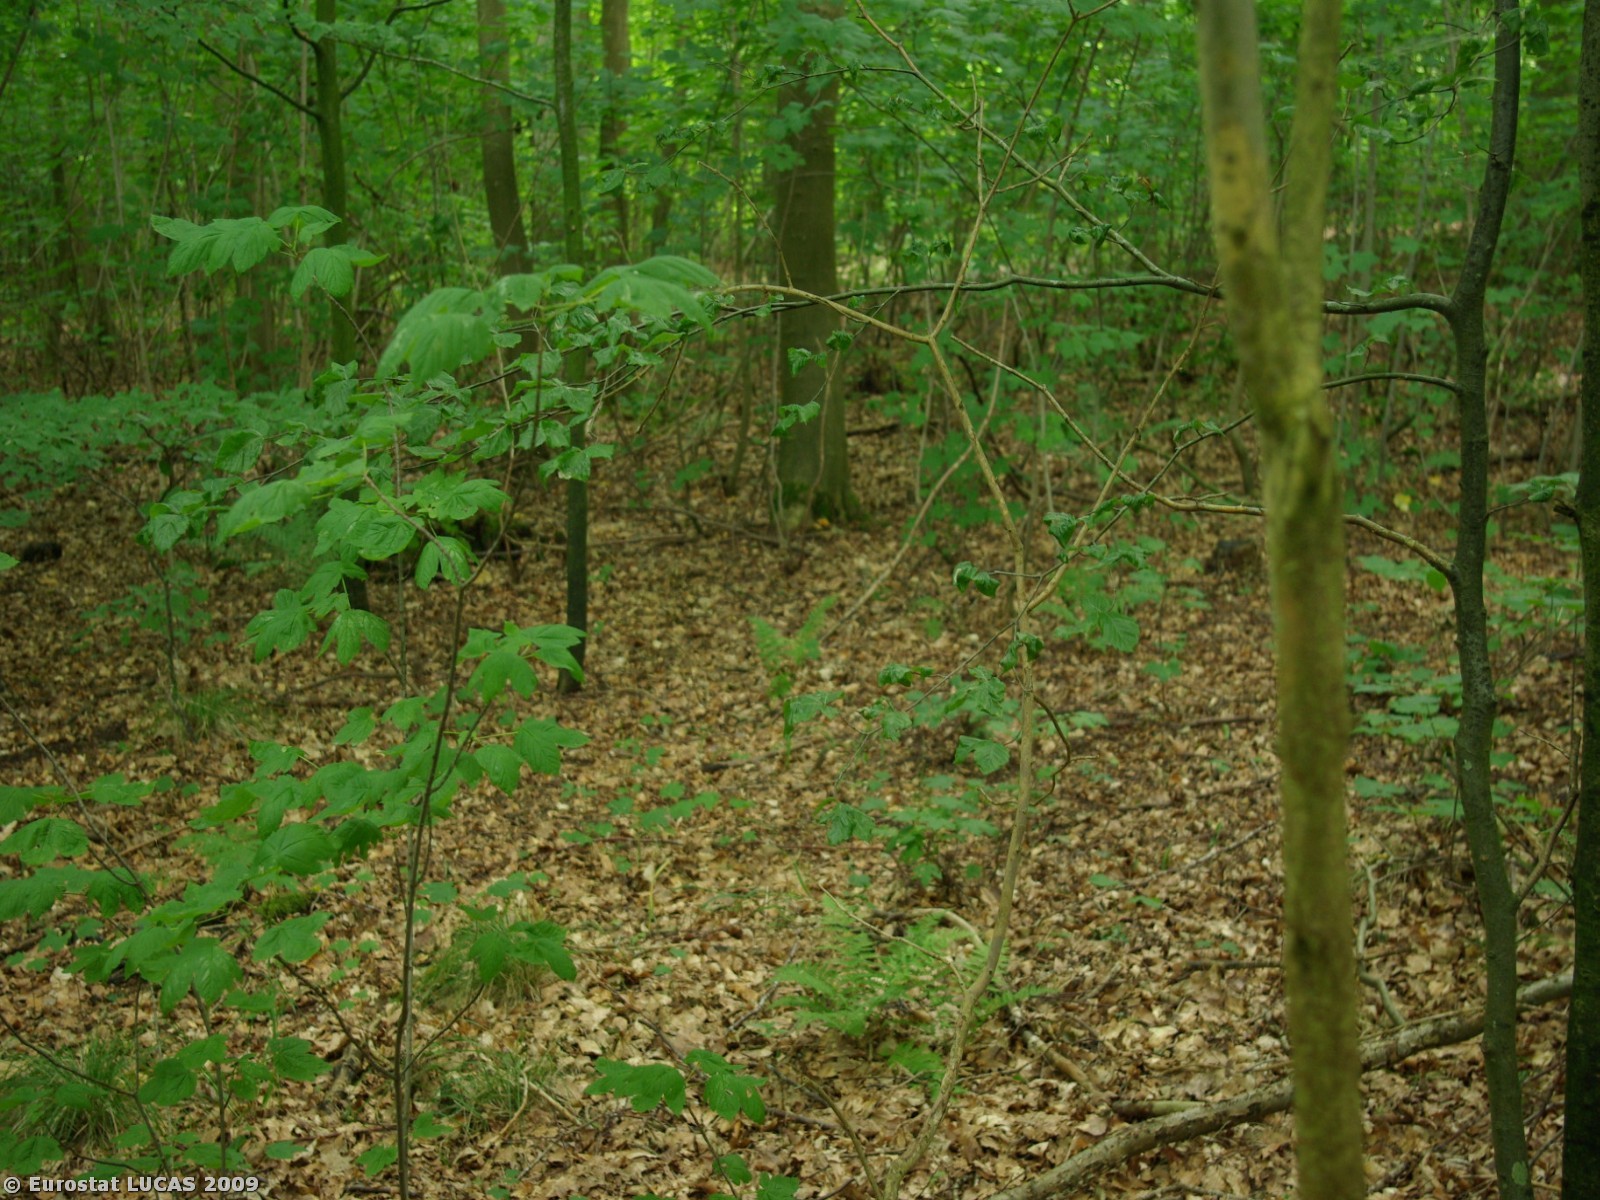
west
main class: Woodland
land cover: Broadleaved woodland
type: mesophytic deciduous forest
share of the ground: > 75 %
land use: Forestry
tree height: > 5 m
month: July
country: DK
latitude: 55.0194
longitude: 9.8906
